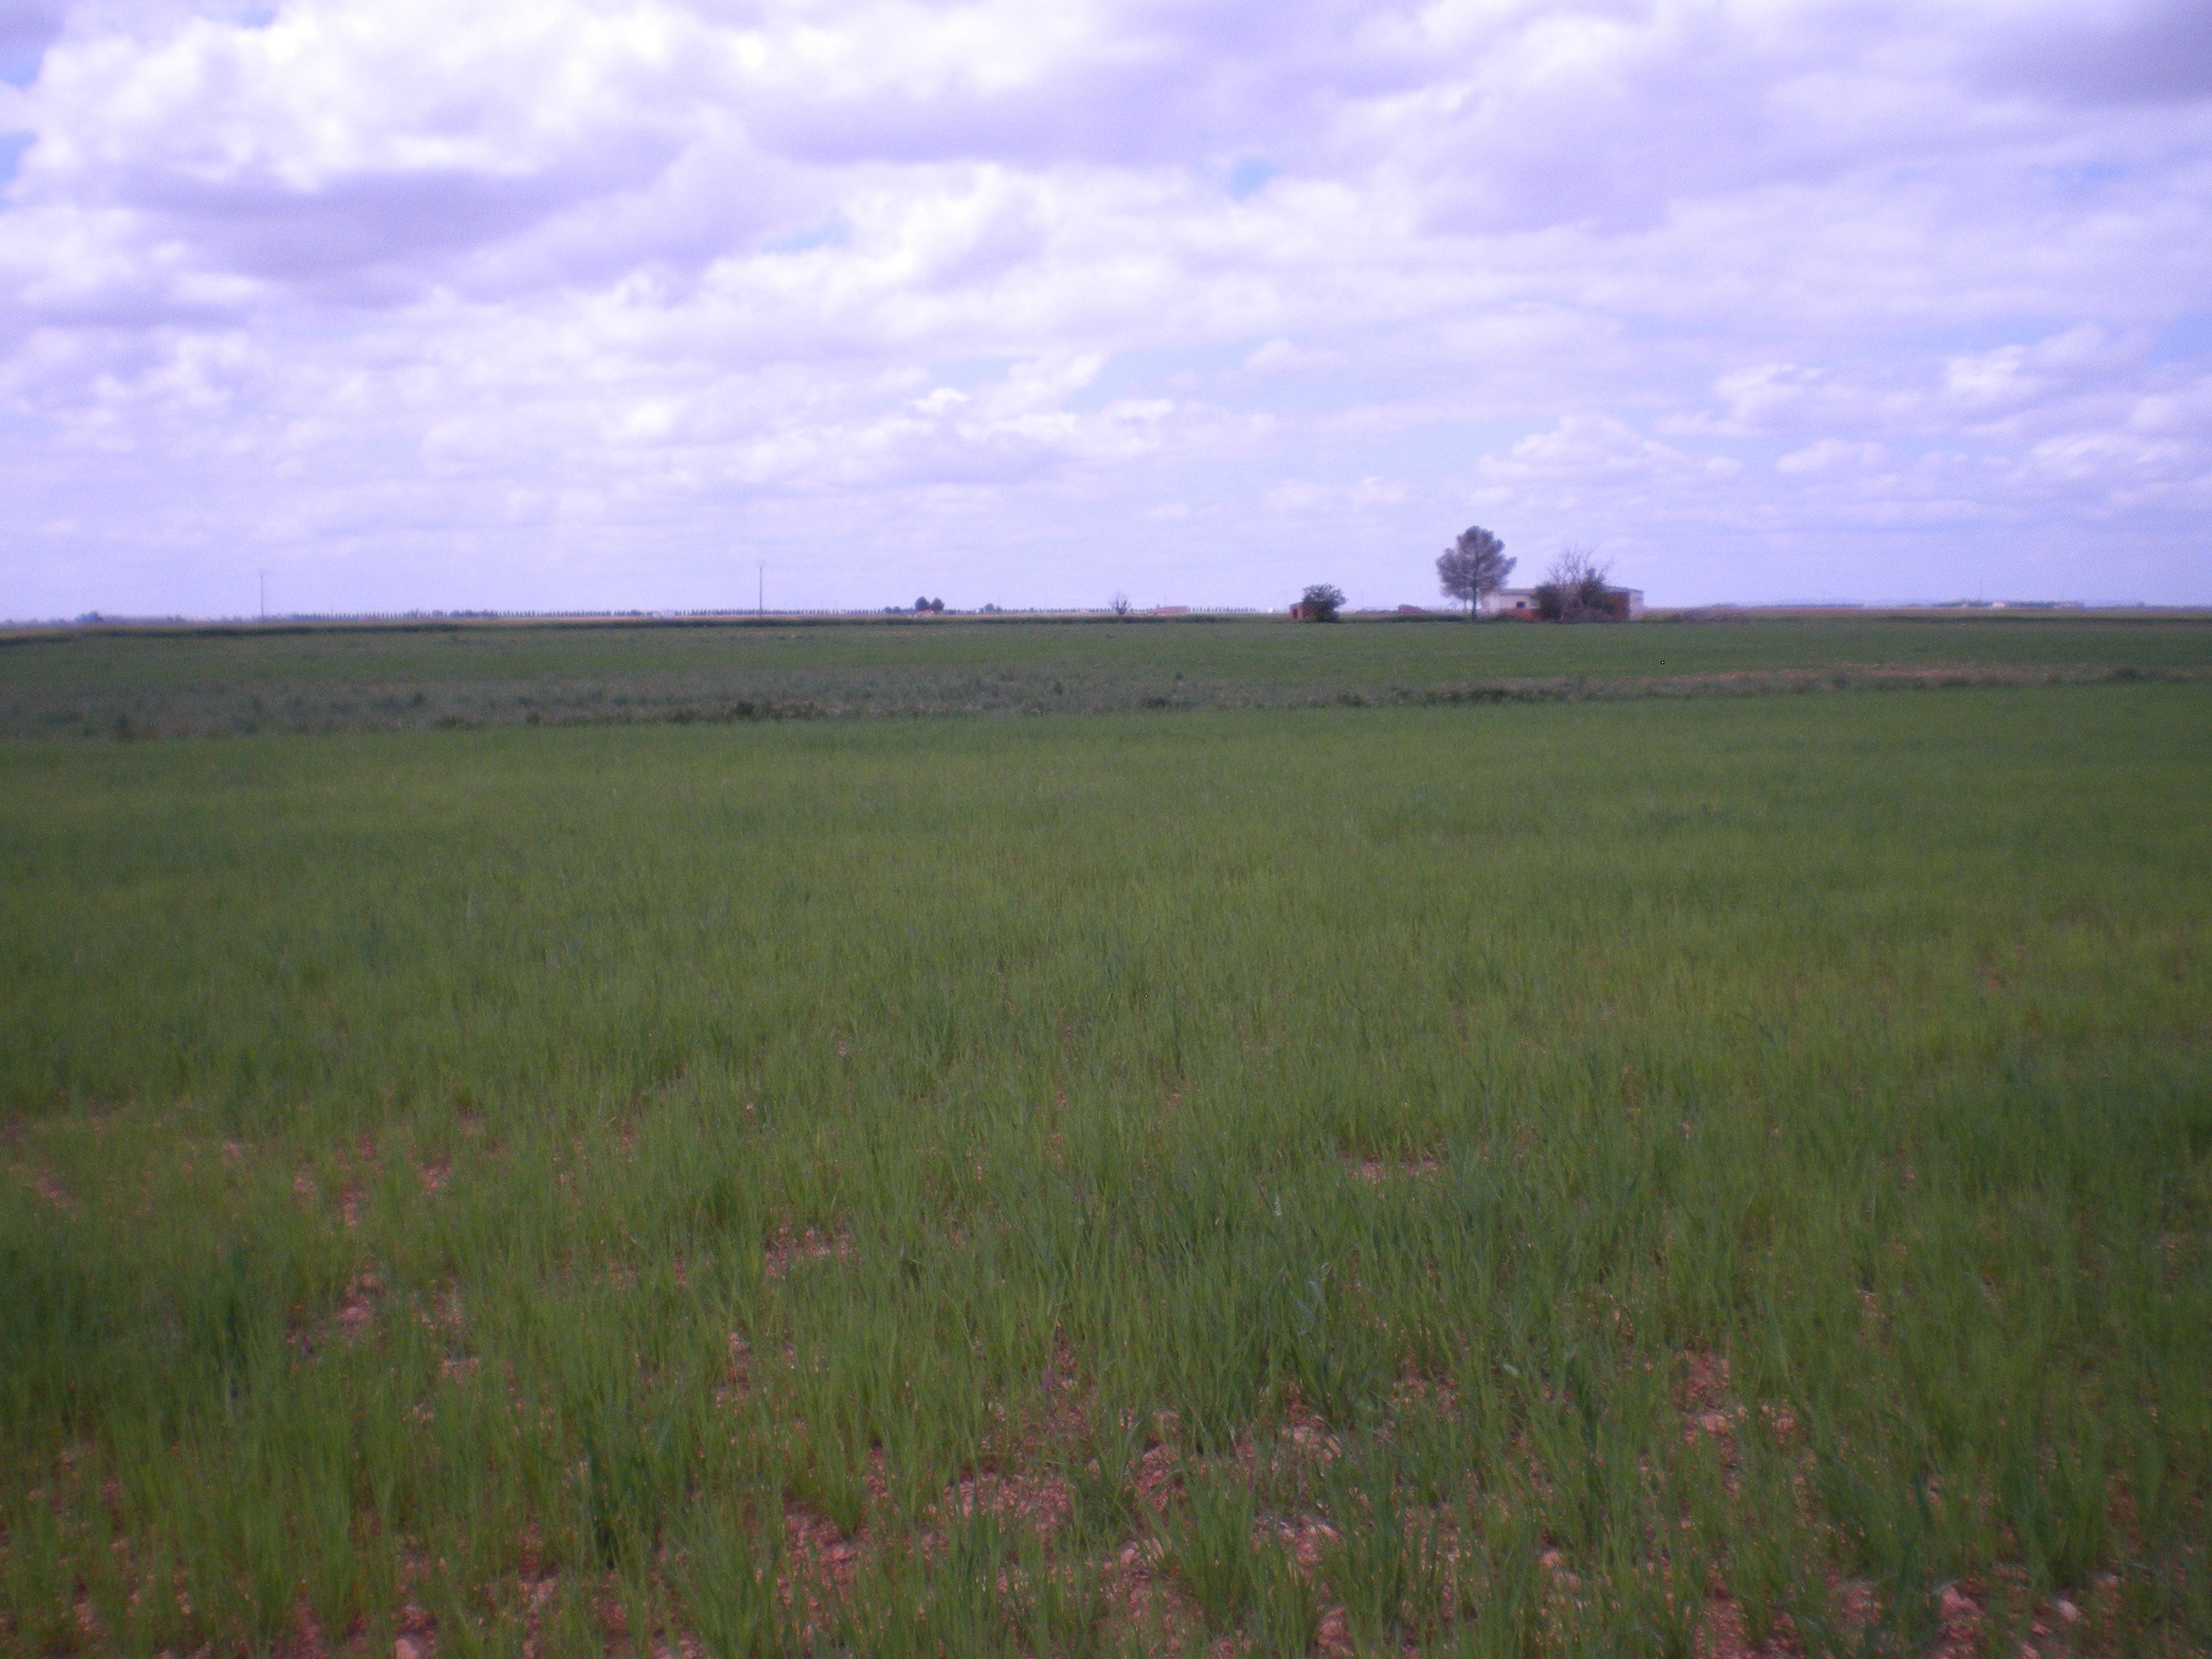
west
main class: Cropland
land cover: Barley
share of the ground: > 75 %
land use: Agriculture (excluding fallow land and kitchen gardens)
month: April
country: ES
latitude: 39.0092
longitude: -3.5625
